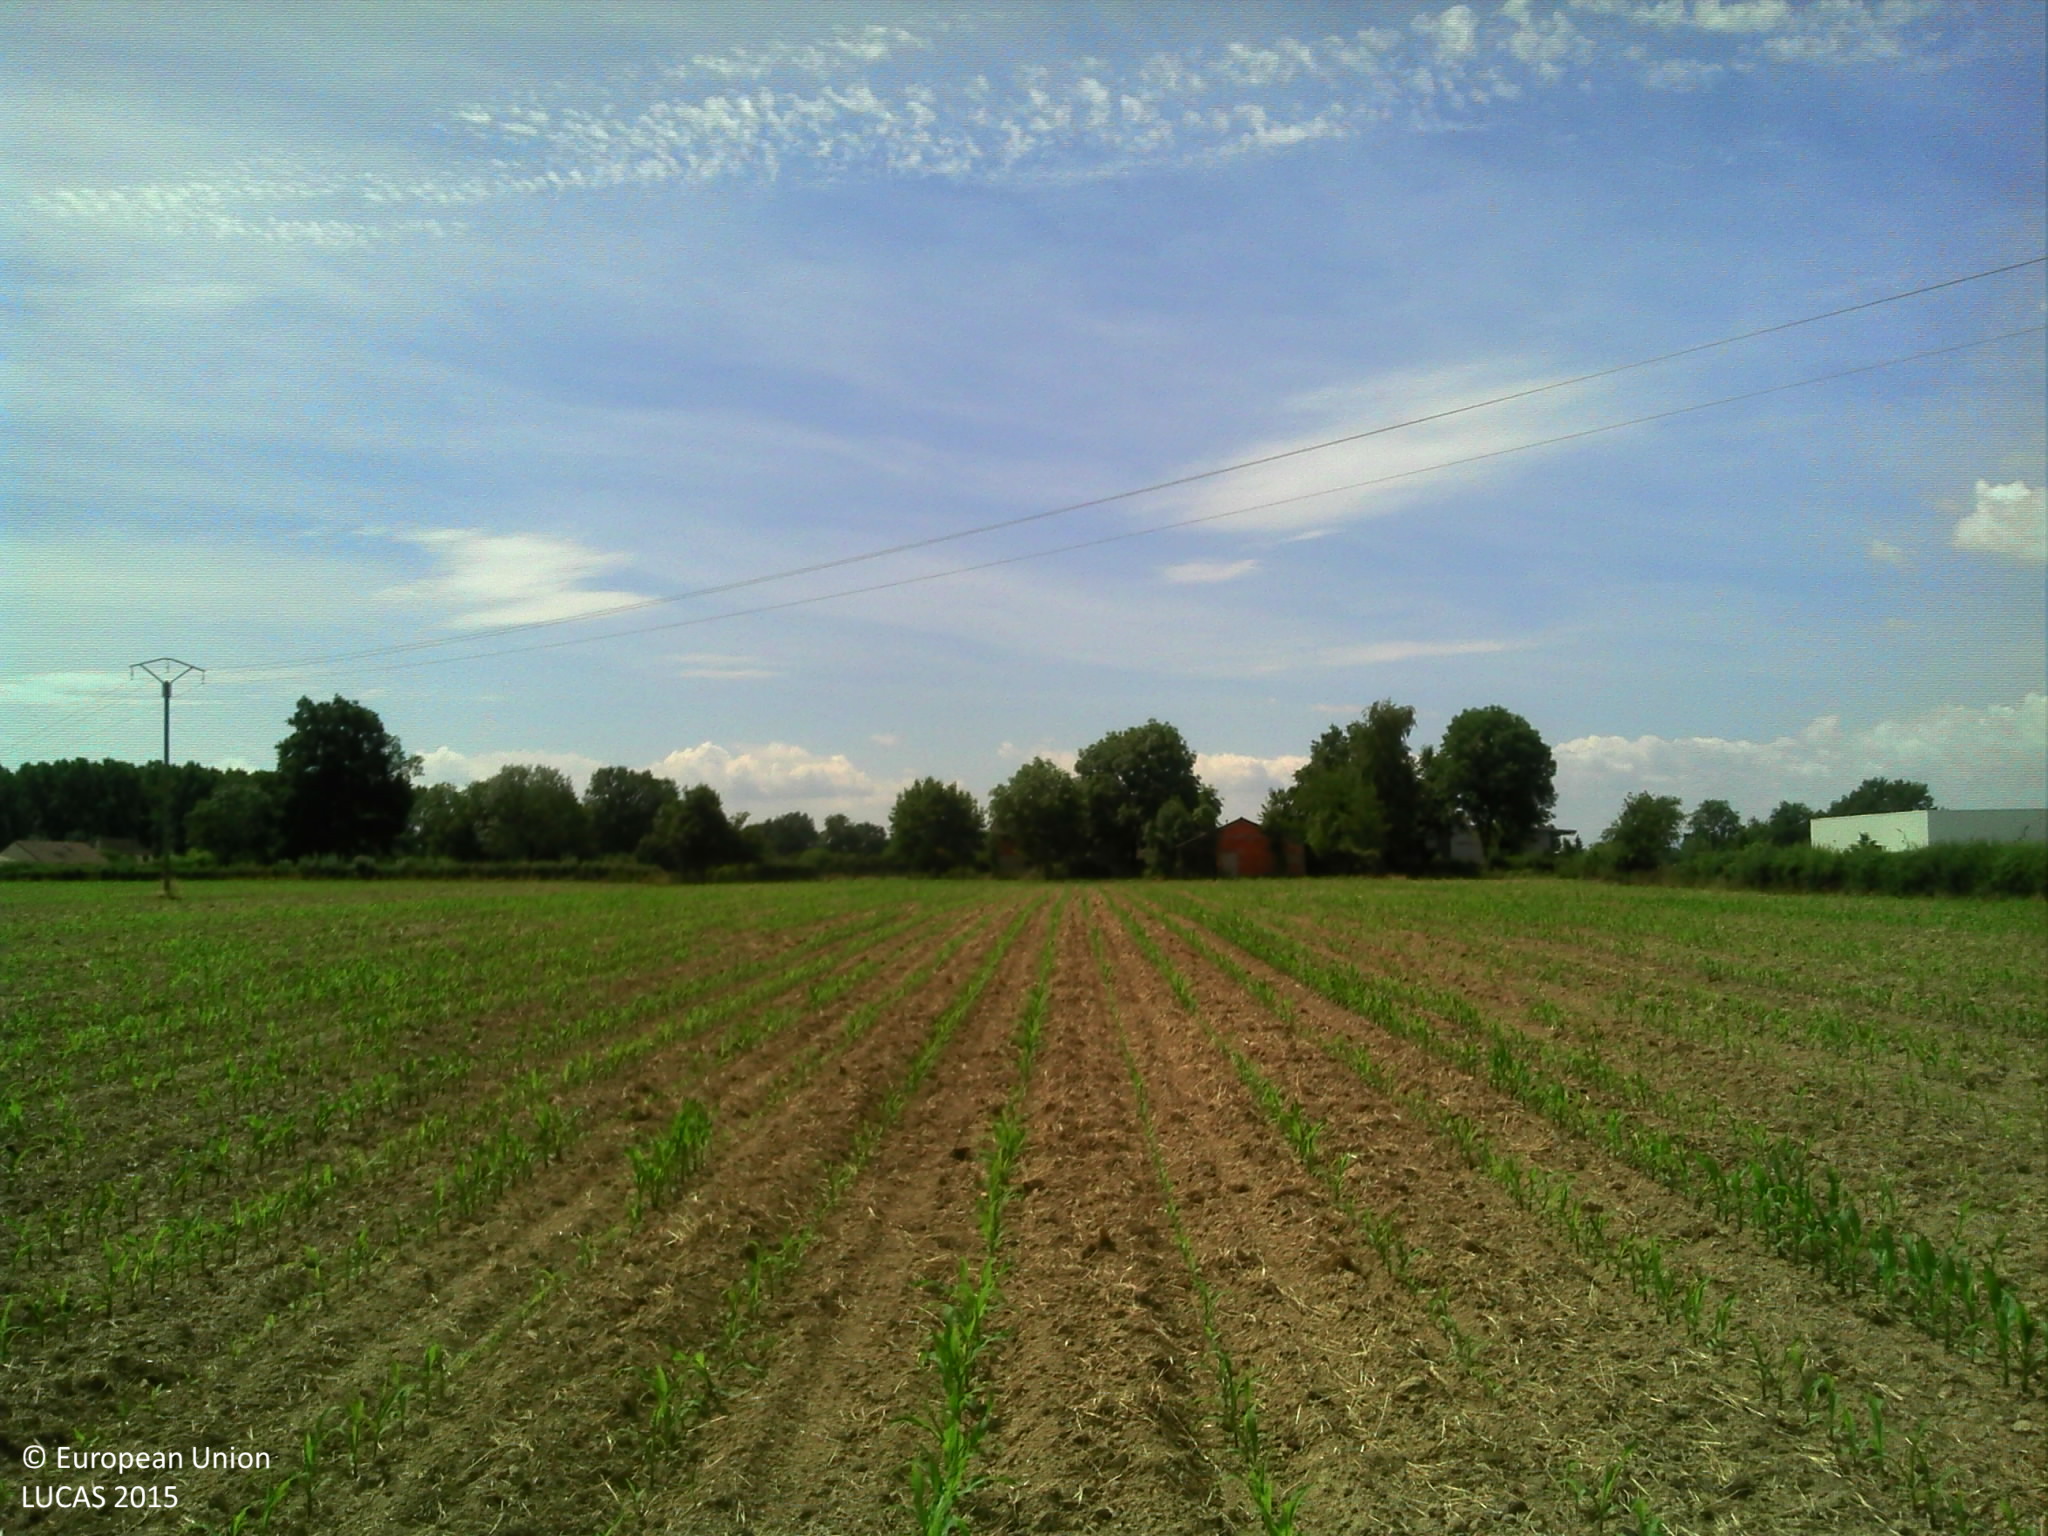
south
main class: Cropland
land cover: Maize
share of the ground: 10 - 25 %
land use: Agriculture (excluding fallow land and kitchen gardens)
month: June
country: FR
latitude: 46.2935
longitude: 4.0425
